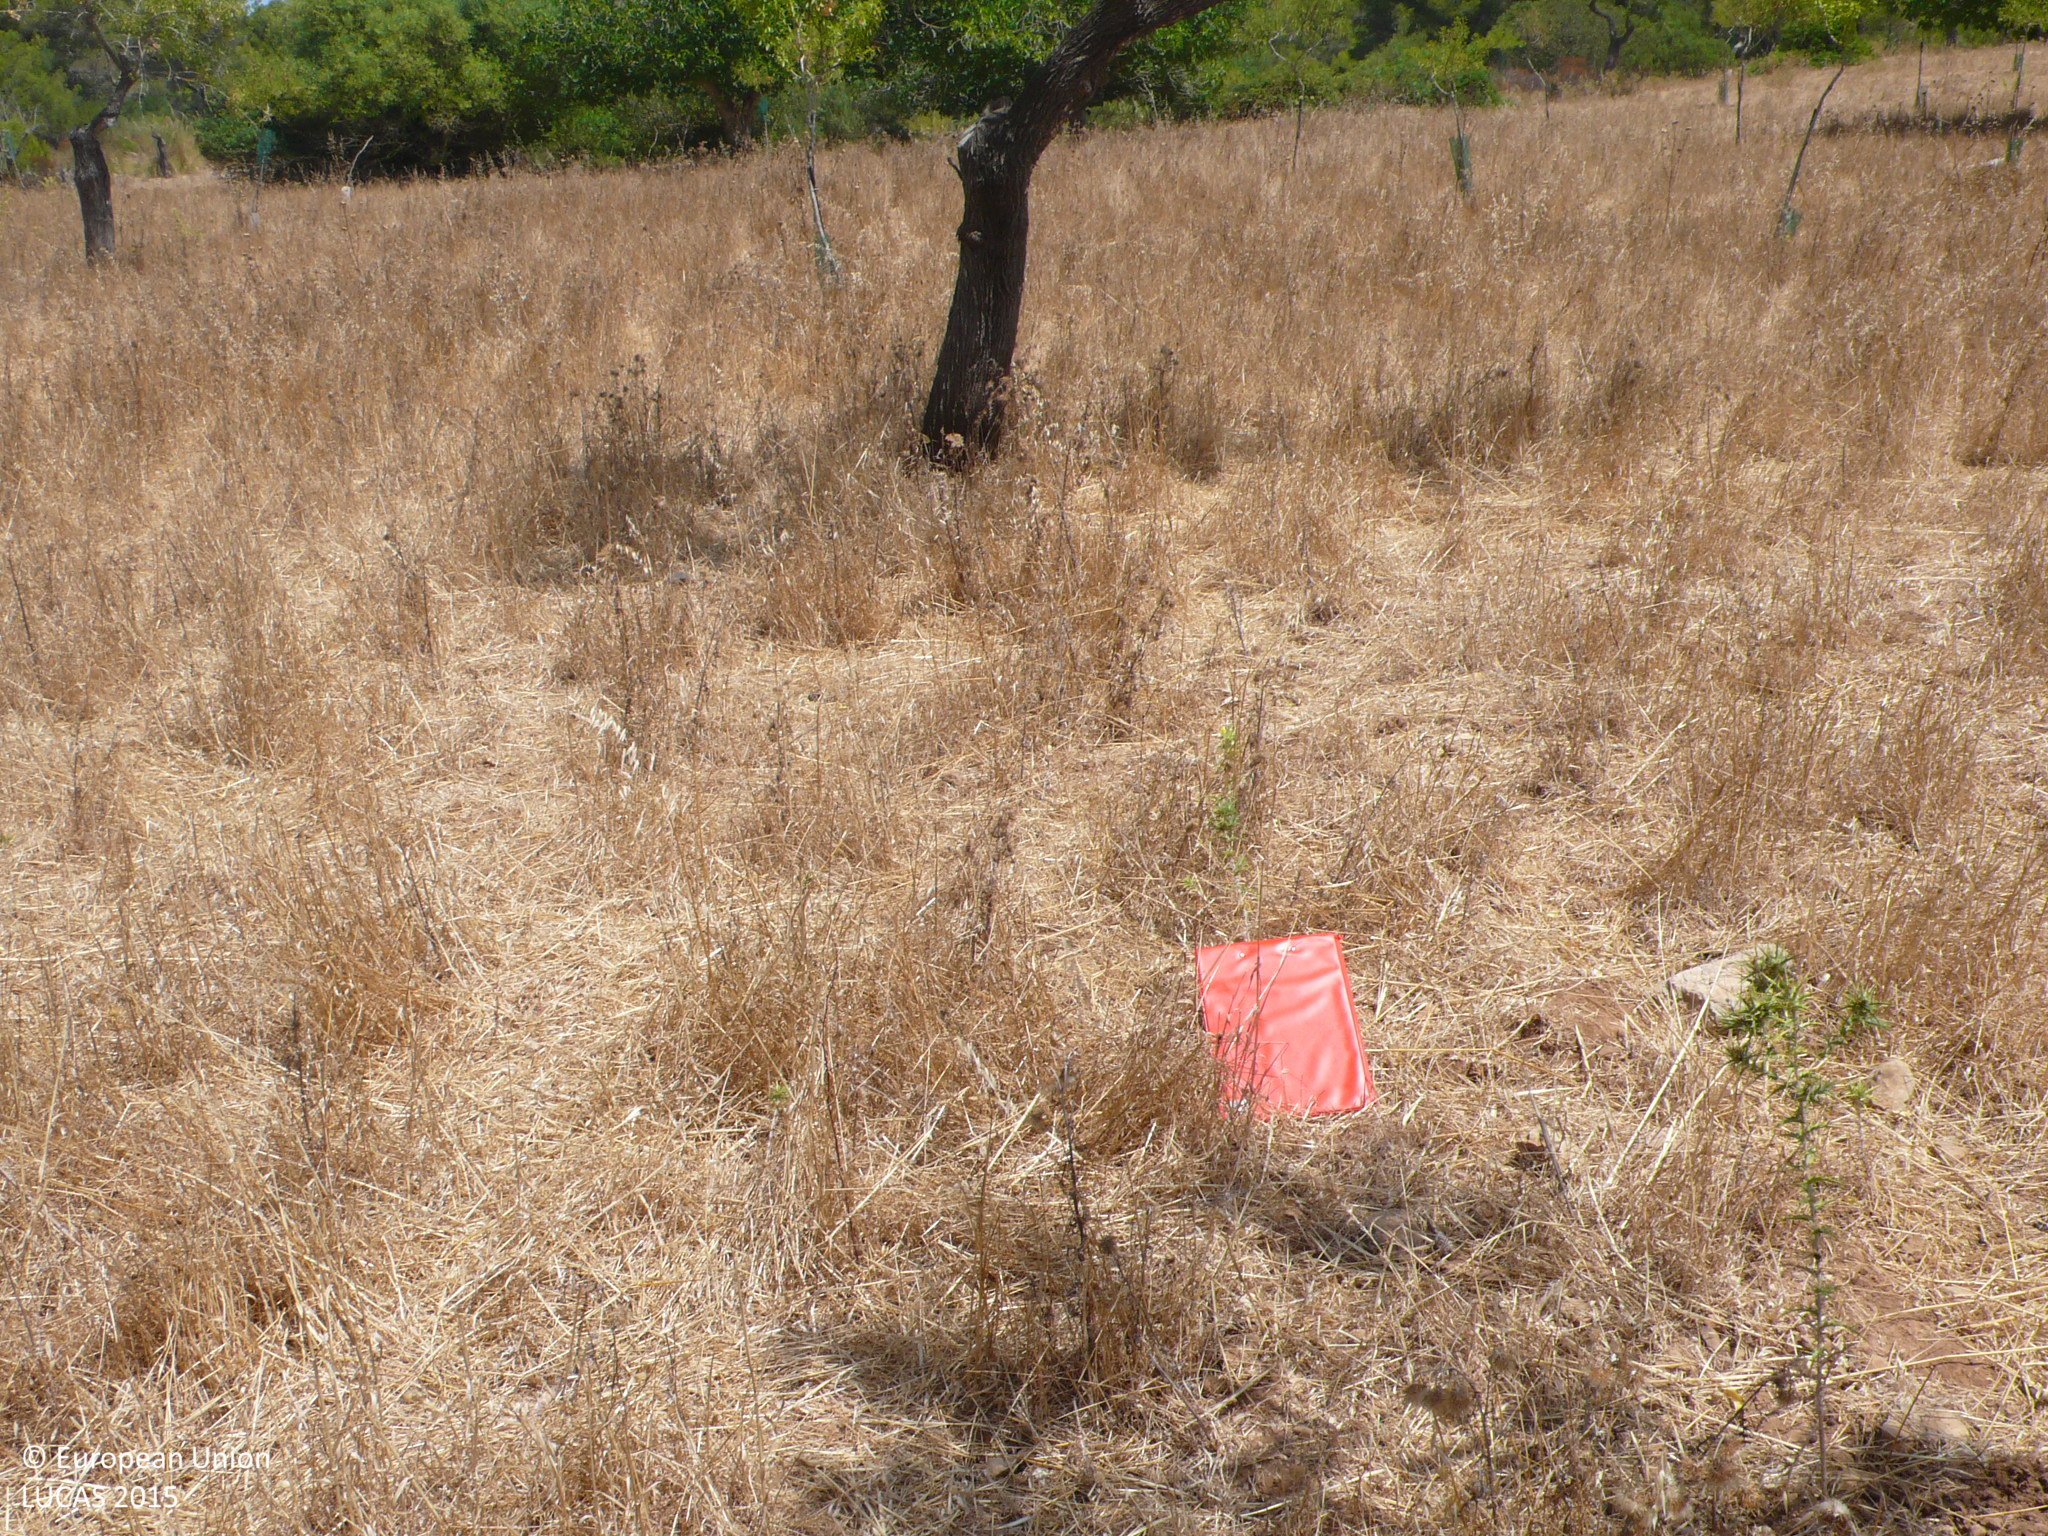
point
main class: Cropland
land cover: Nuts trees
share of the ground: 10 - 25 %
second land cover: Spontaneously vegetated surfaces
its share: > 75 %
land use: Agriculture (excluding fallow land and kitchen gardens)
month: July
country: ES
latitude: 39.6226
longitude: 3.3310
